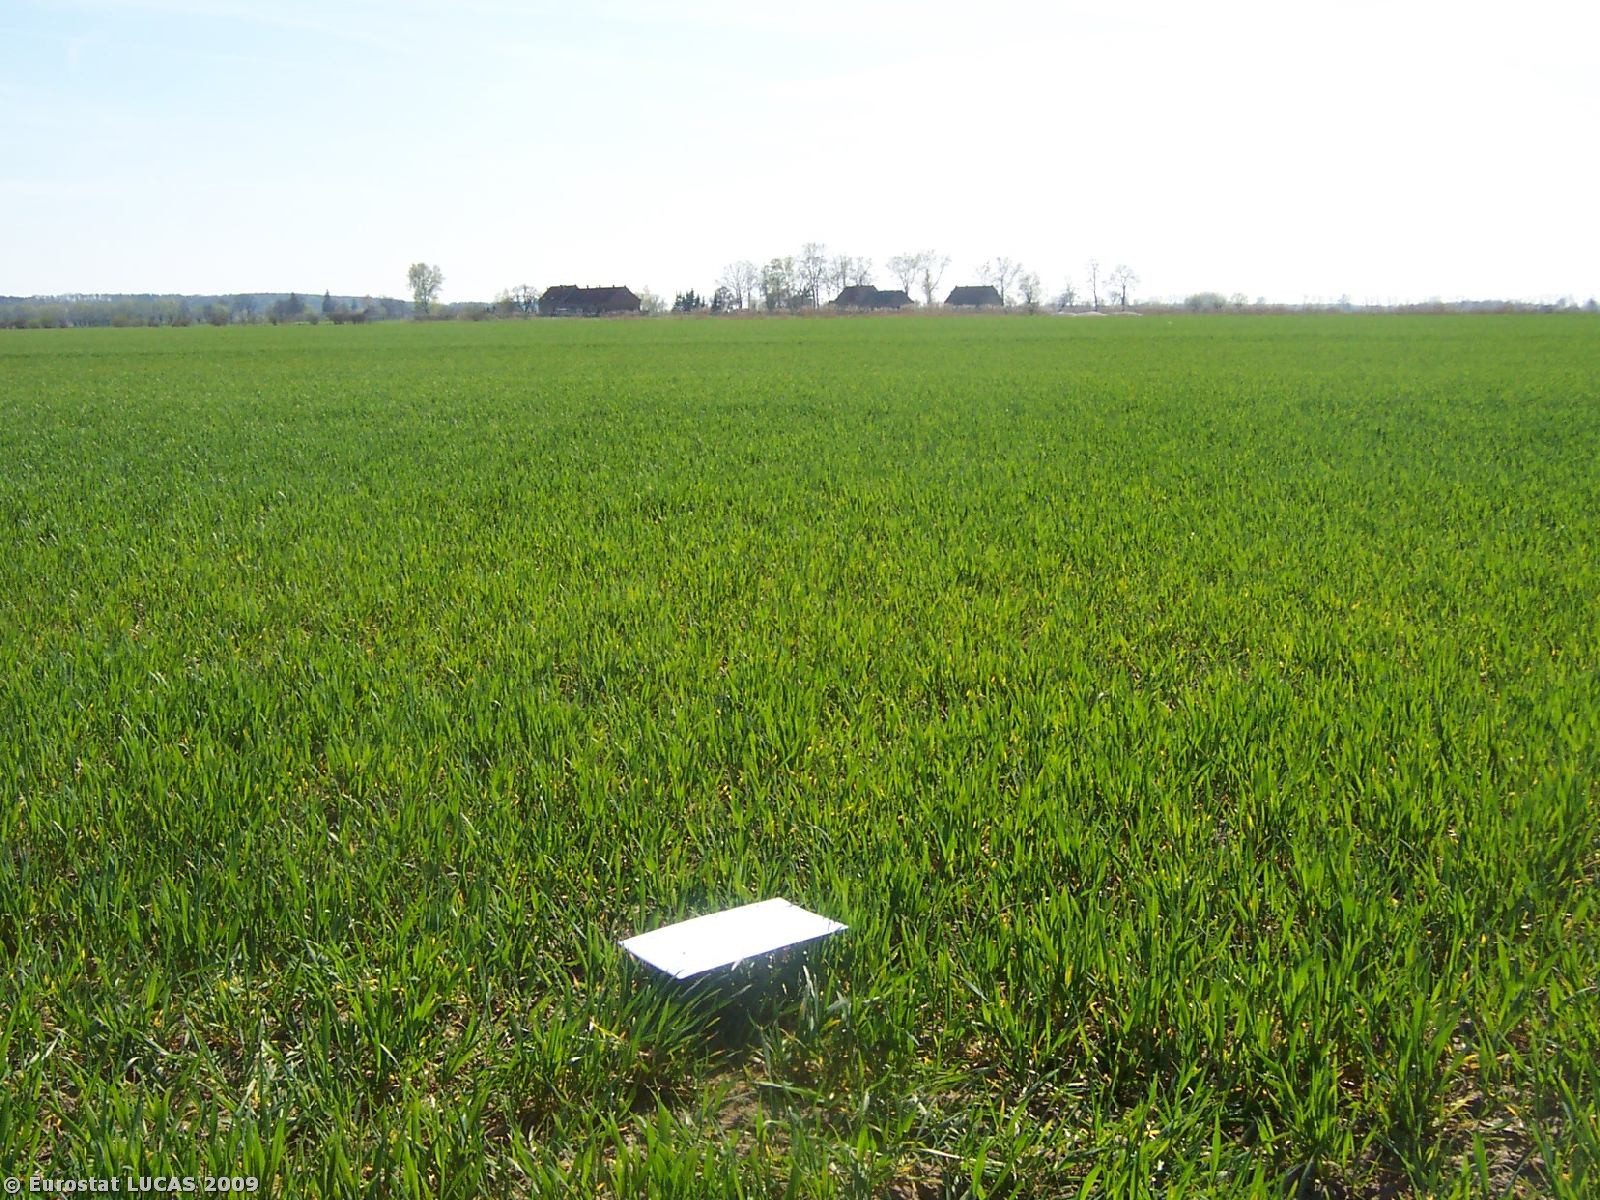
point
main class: Cropland
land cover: Common wheat
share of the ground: 25 - 50 %
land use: Agriculture (excluding fallow land and kitchen gardens)
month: April
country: PL
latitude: 54.0109
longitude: 18.9480
